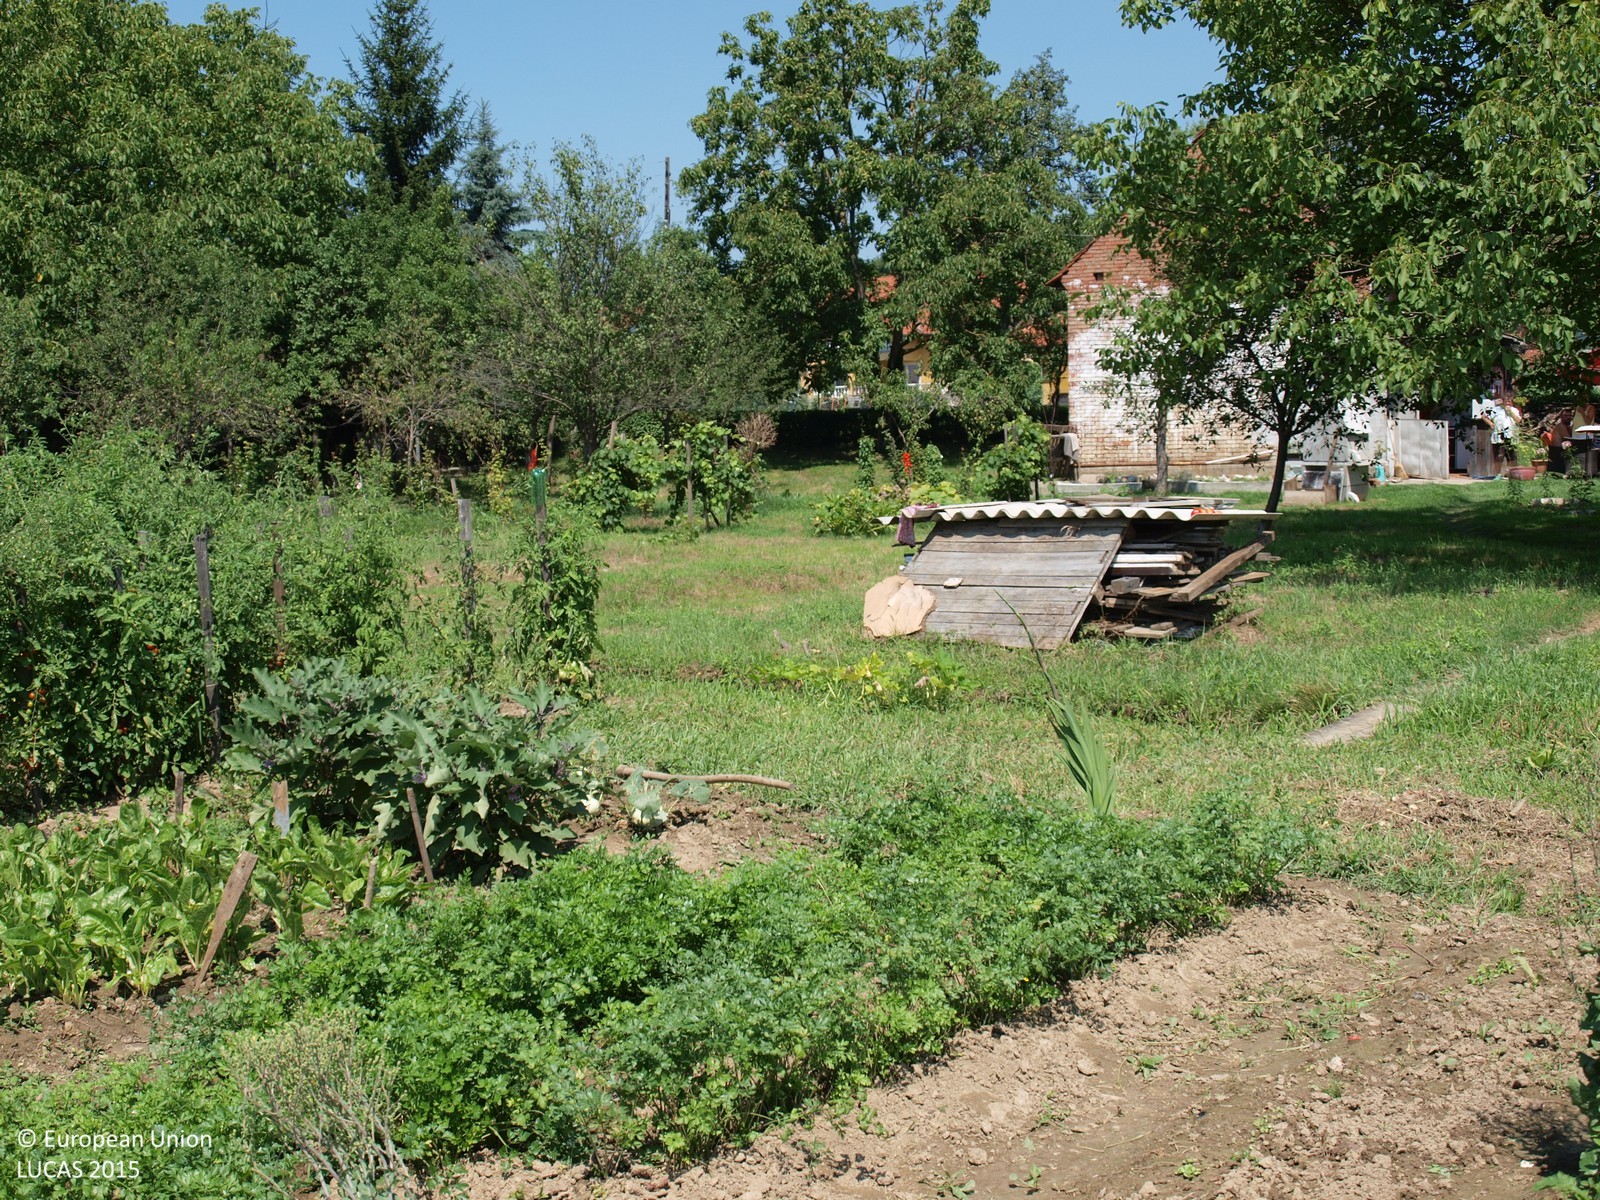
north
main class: Cropland
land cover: Other root crops
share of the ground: > 75 %
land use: Kitchen garden
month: August
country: HR
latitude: 45.8421
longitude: 16.2692
